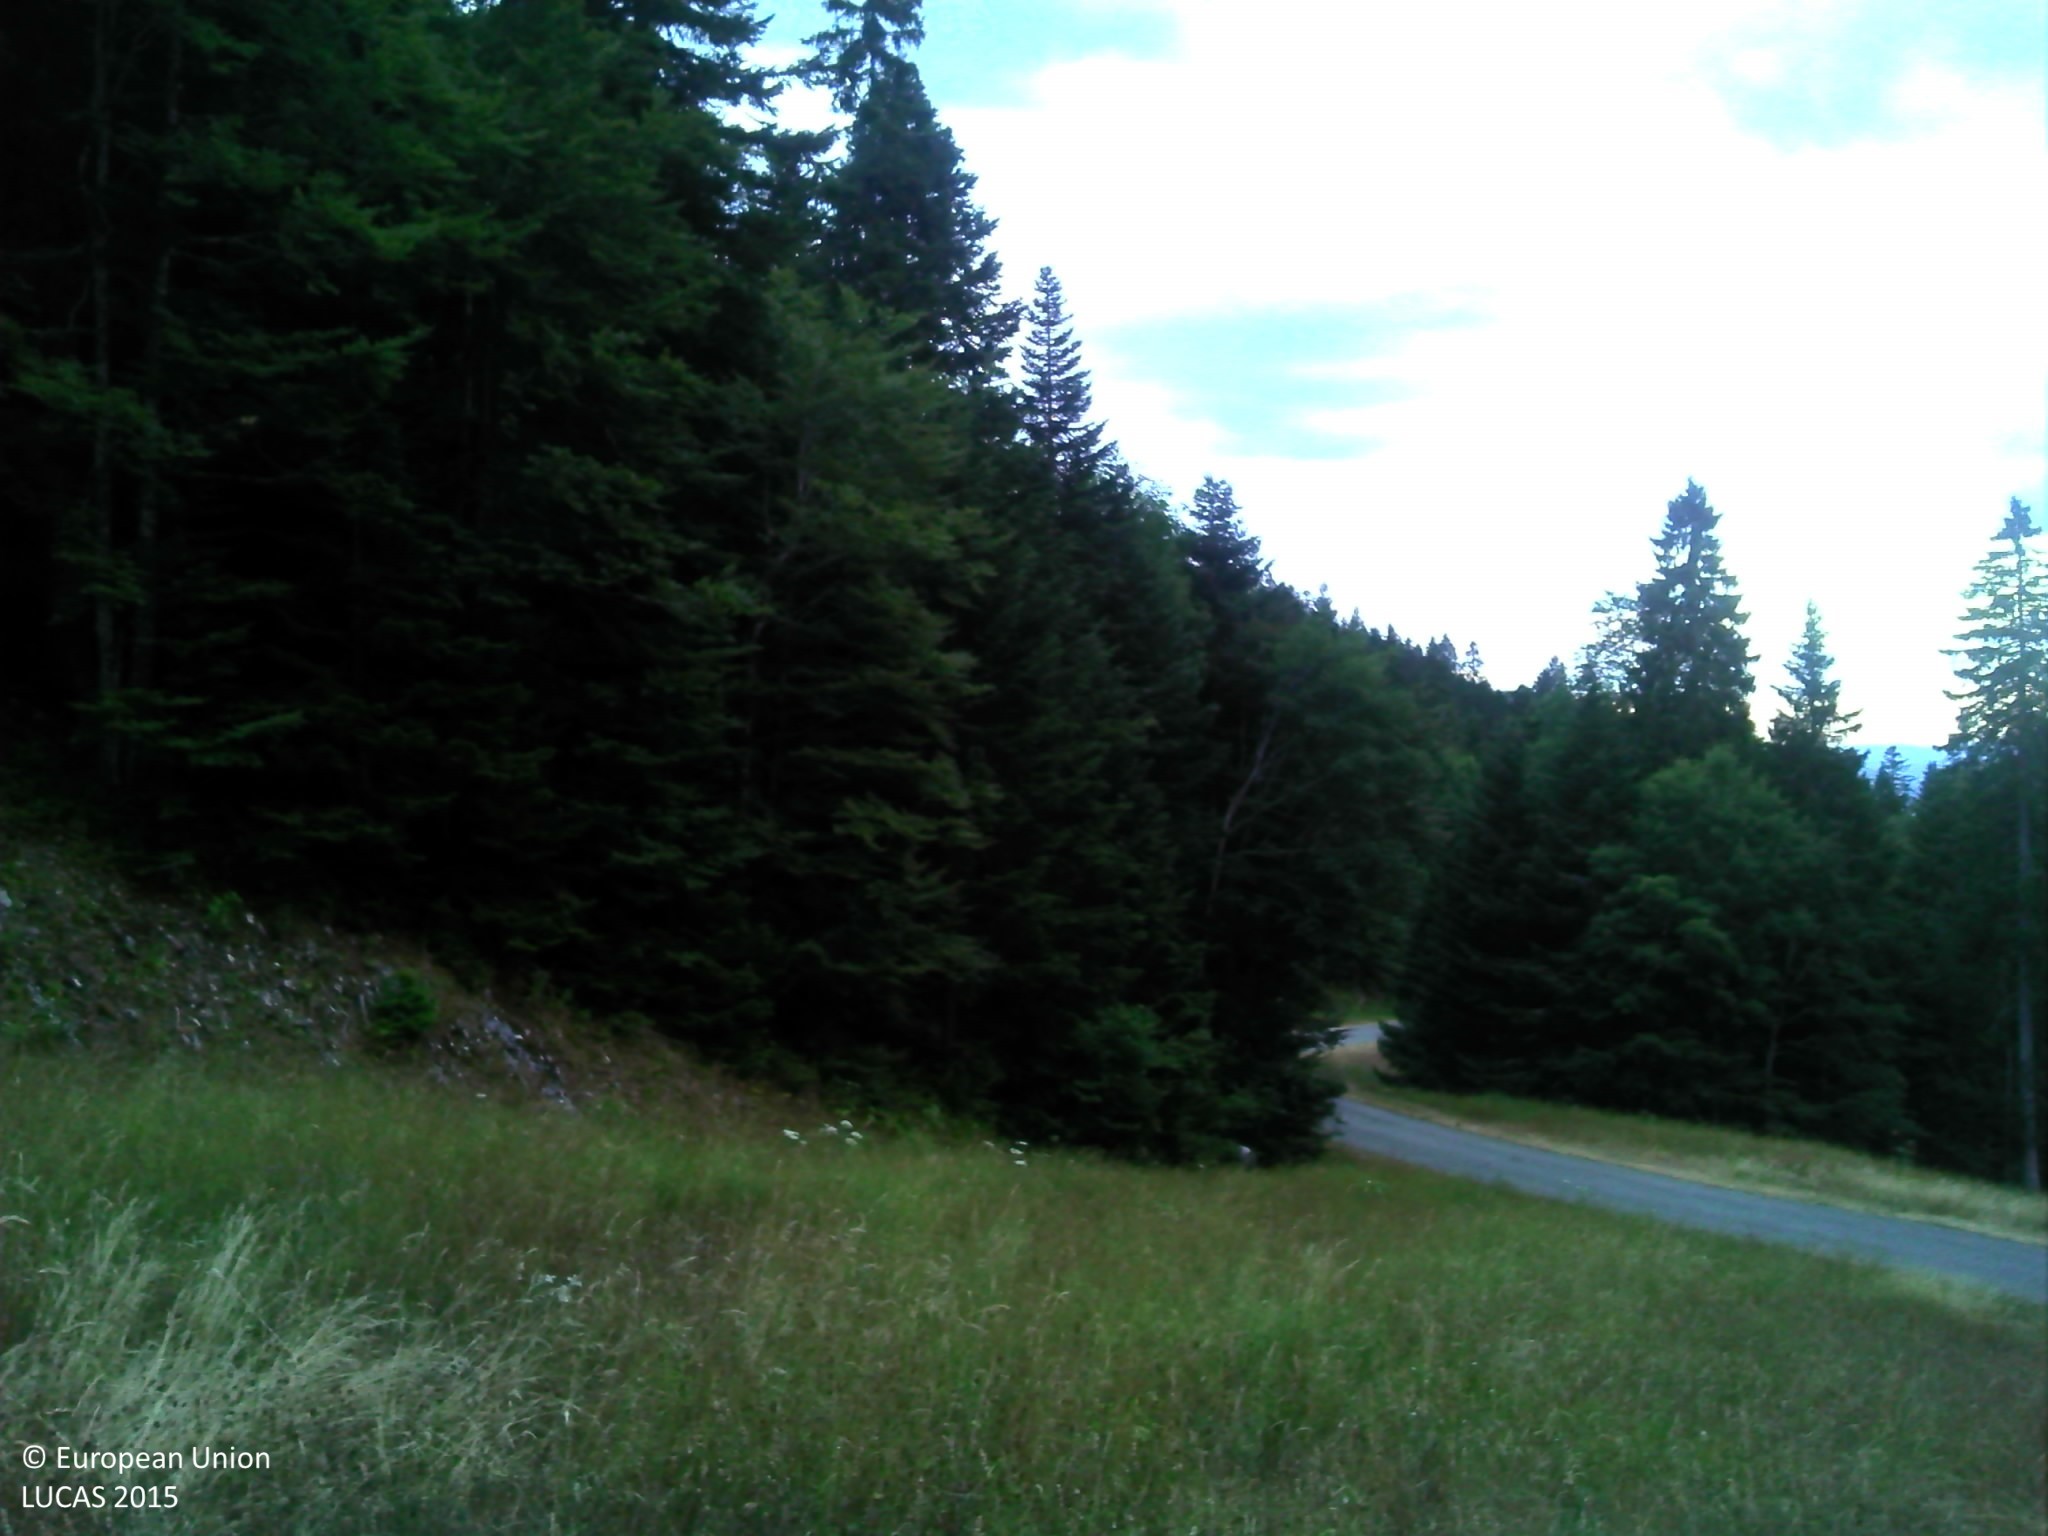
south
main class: Grassland
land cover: Grassland without tree/shrub cover
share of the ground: > 75 %
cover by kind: herbaceous plants 100 %
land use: Agriculture (excluding fallow land and kitchen gardens)
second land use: Sport
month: July
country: FR
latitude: 45.2316
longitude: 5.5854
